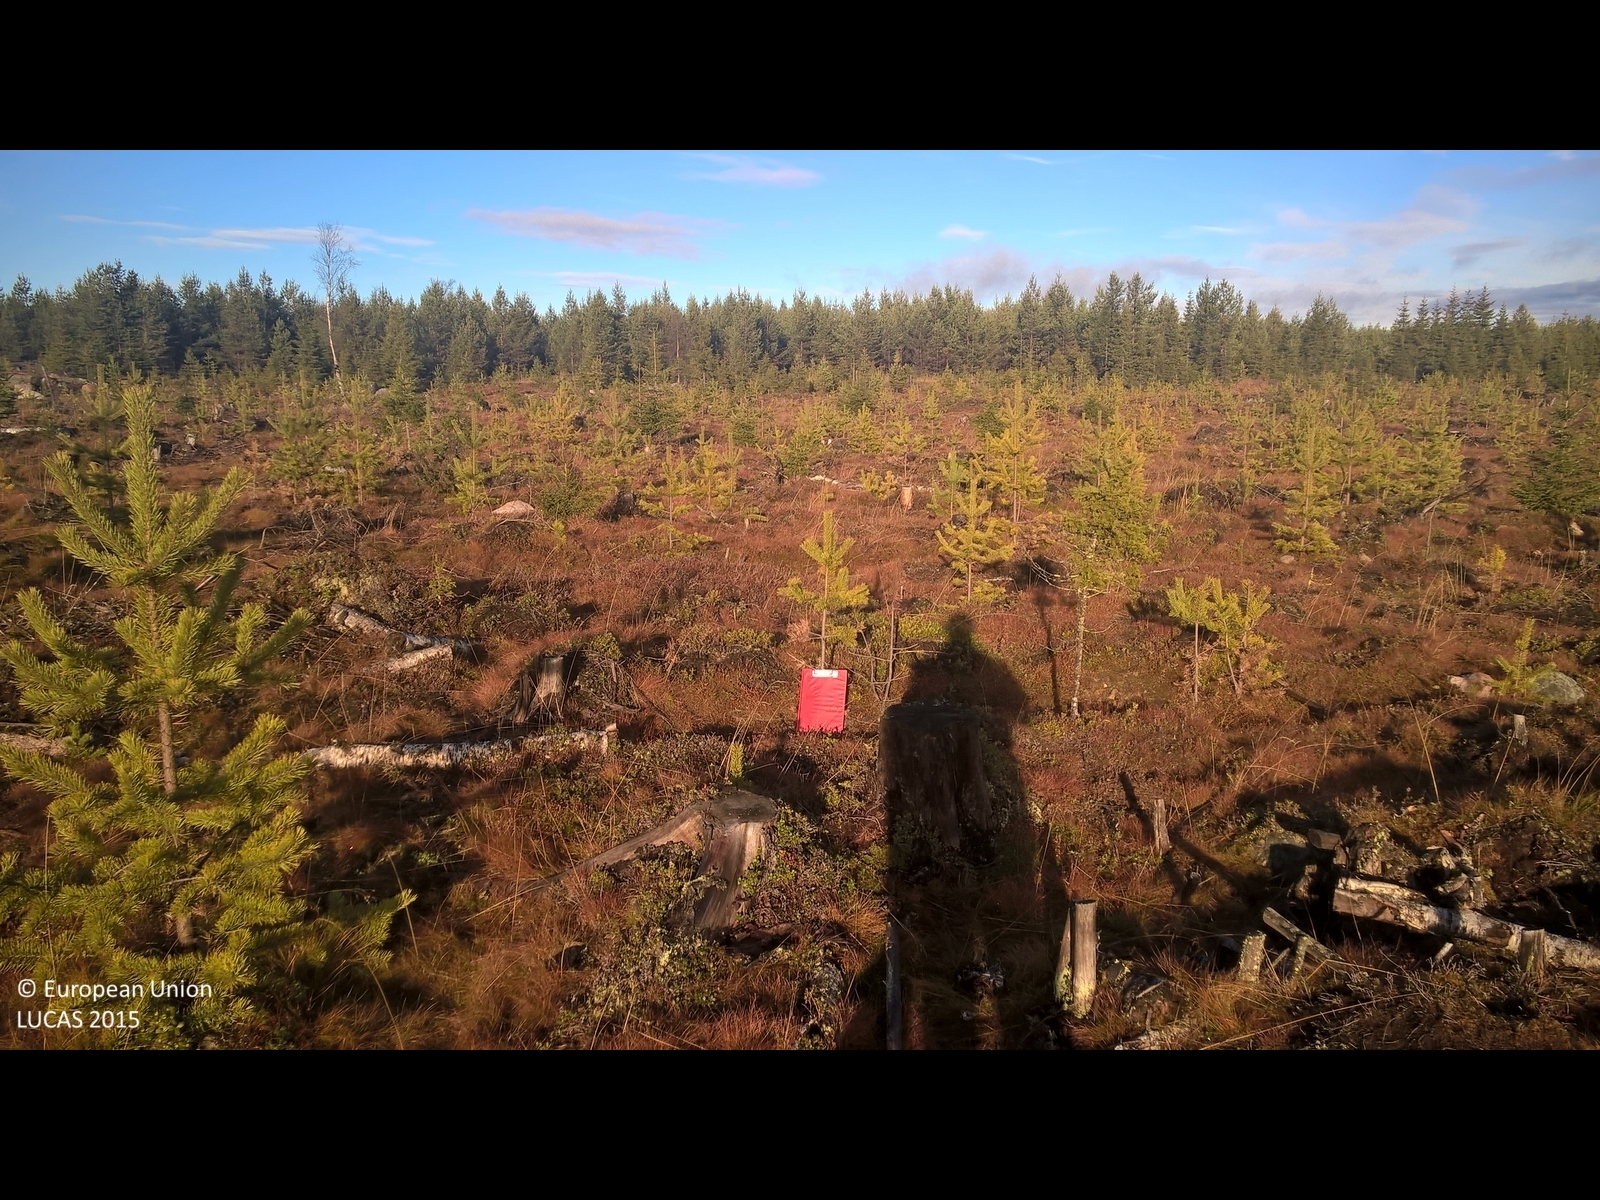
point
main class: Woodland
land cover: Pine dominated coniferous woodland
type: boreal forest
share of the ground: 50 - 75 %
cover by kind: coniferous forest trees 50 %, shrubs 25 %, herbaceous plants 25 %
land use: Forestry
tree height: < 5 m
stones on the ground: < 10 %
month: October
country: SE
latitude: 65.3595
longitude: 18.7104
